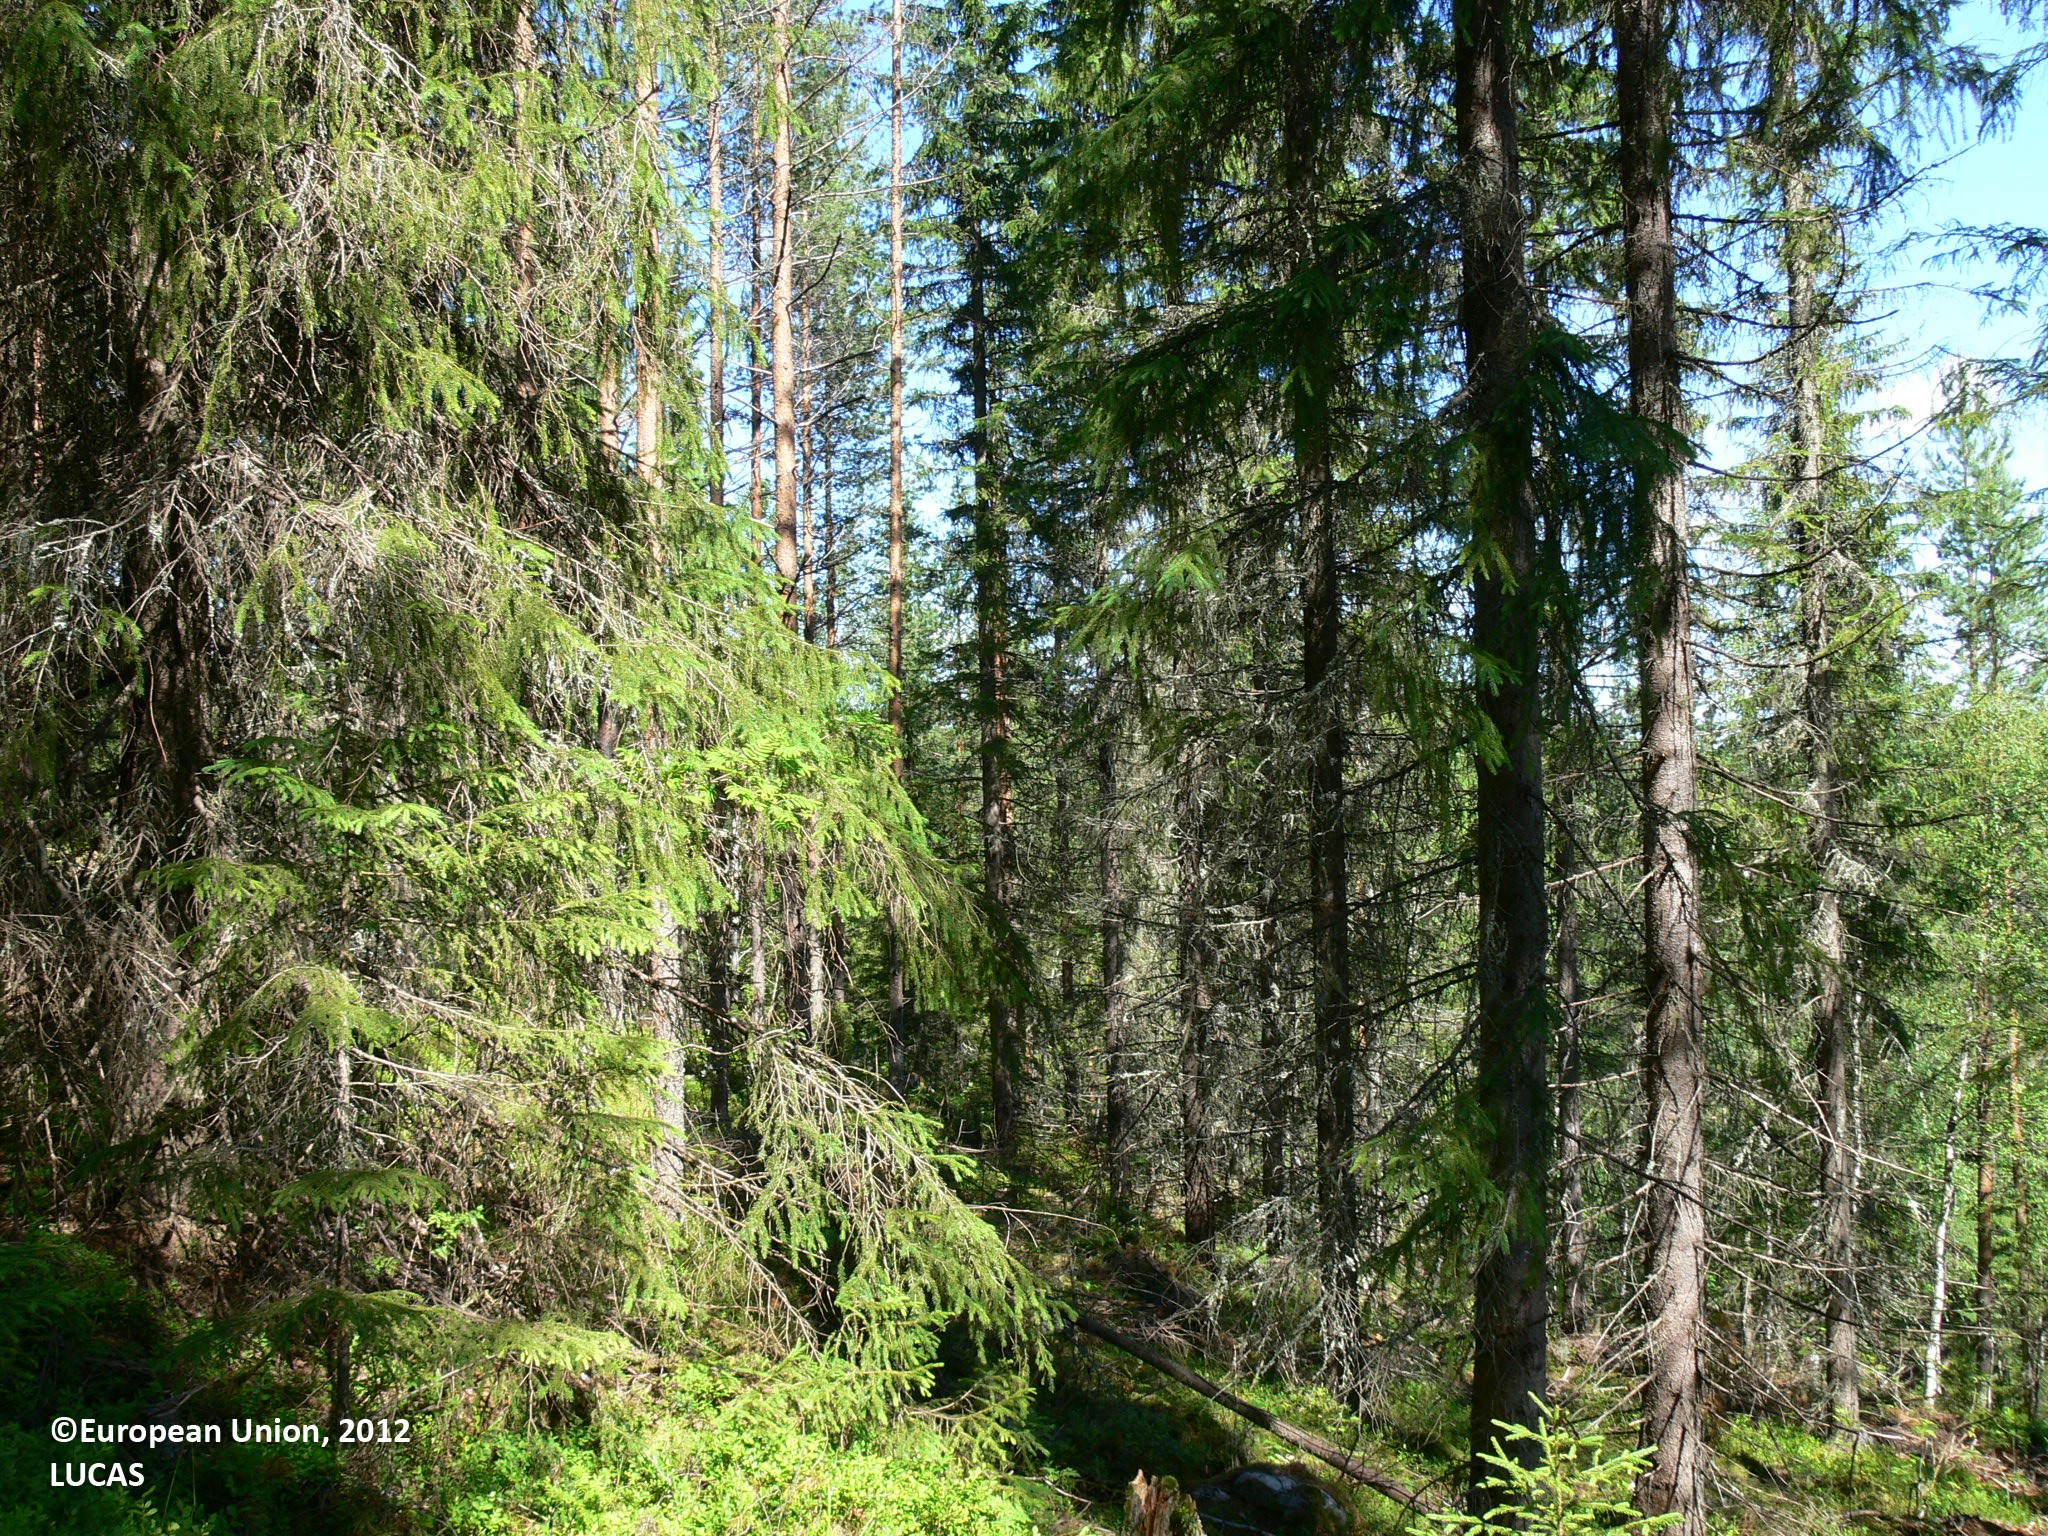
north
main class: Woodland
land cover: Other coniferous woodland
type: boreal forest
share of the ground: 50 - 75 %
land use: Forestry
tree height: > 5 m
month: July
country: FI
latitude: 62.9704
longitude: 29.9980
